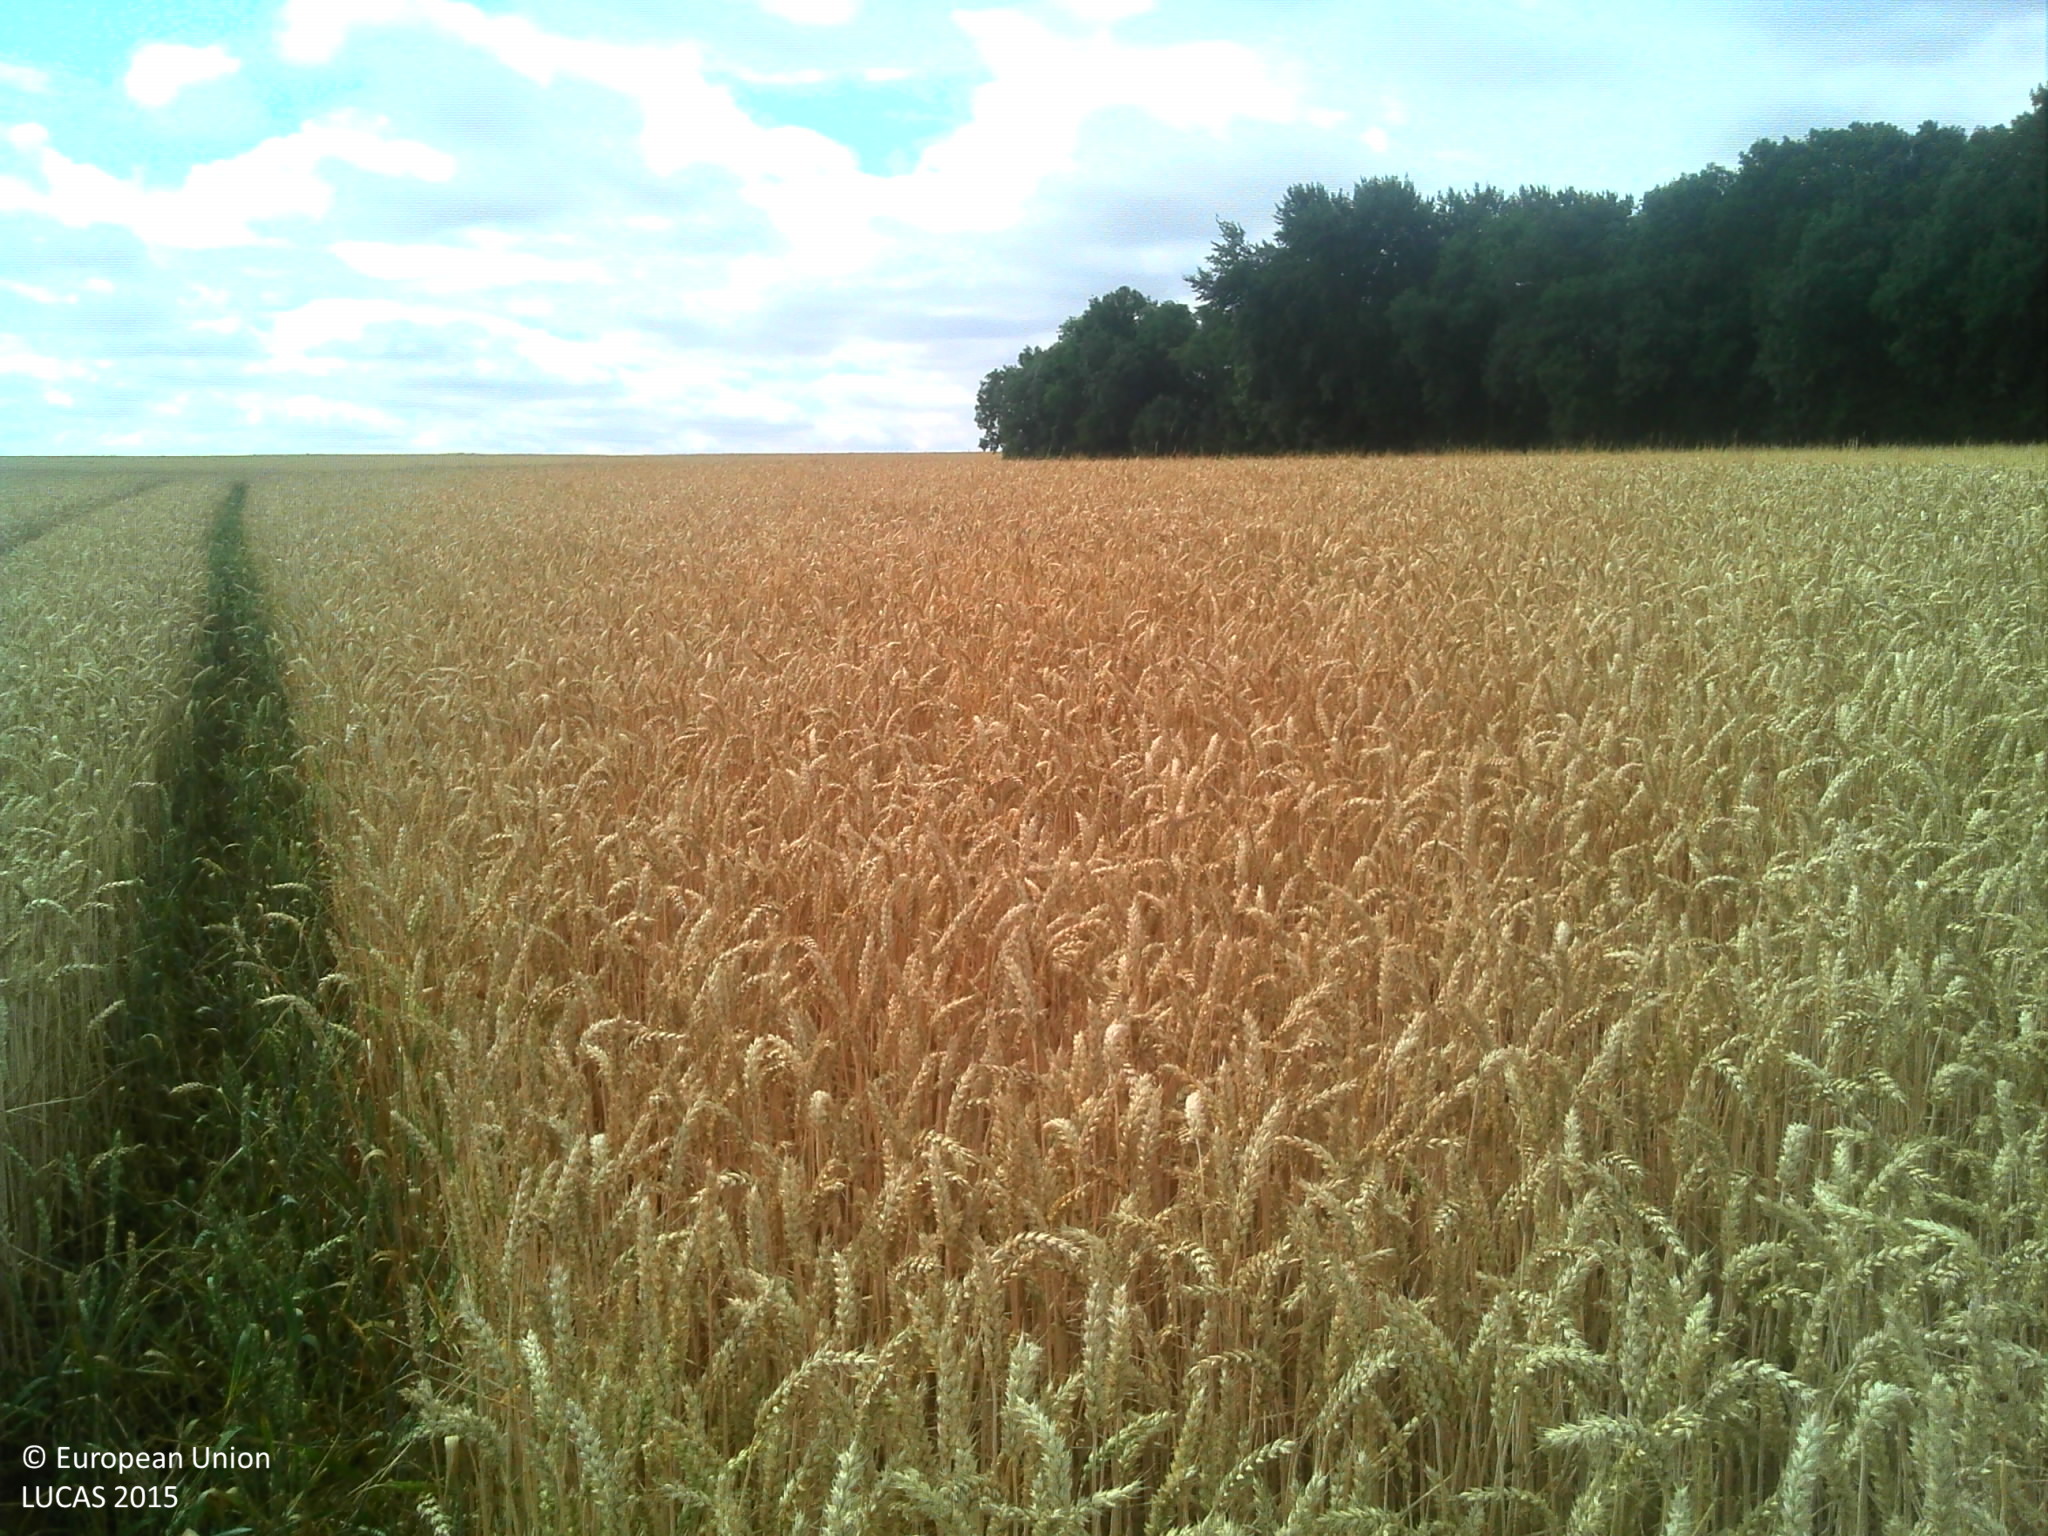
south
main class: Cropland
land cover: Common wheat
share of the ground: > 75 %
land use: Agriculture (excluding fallow land and kitchen gardens)
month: July
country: FR
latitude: 49.2636
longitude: 3.2724
